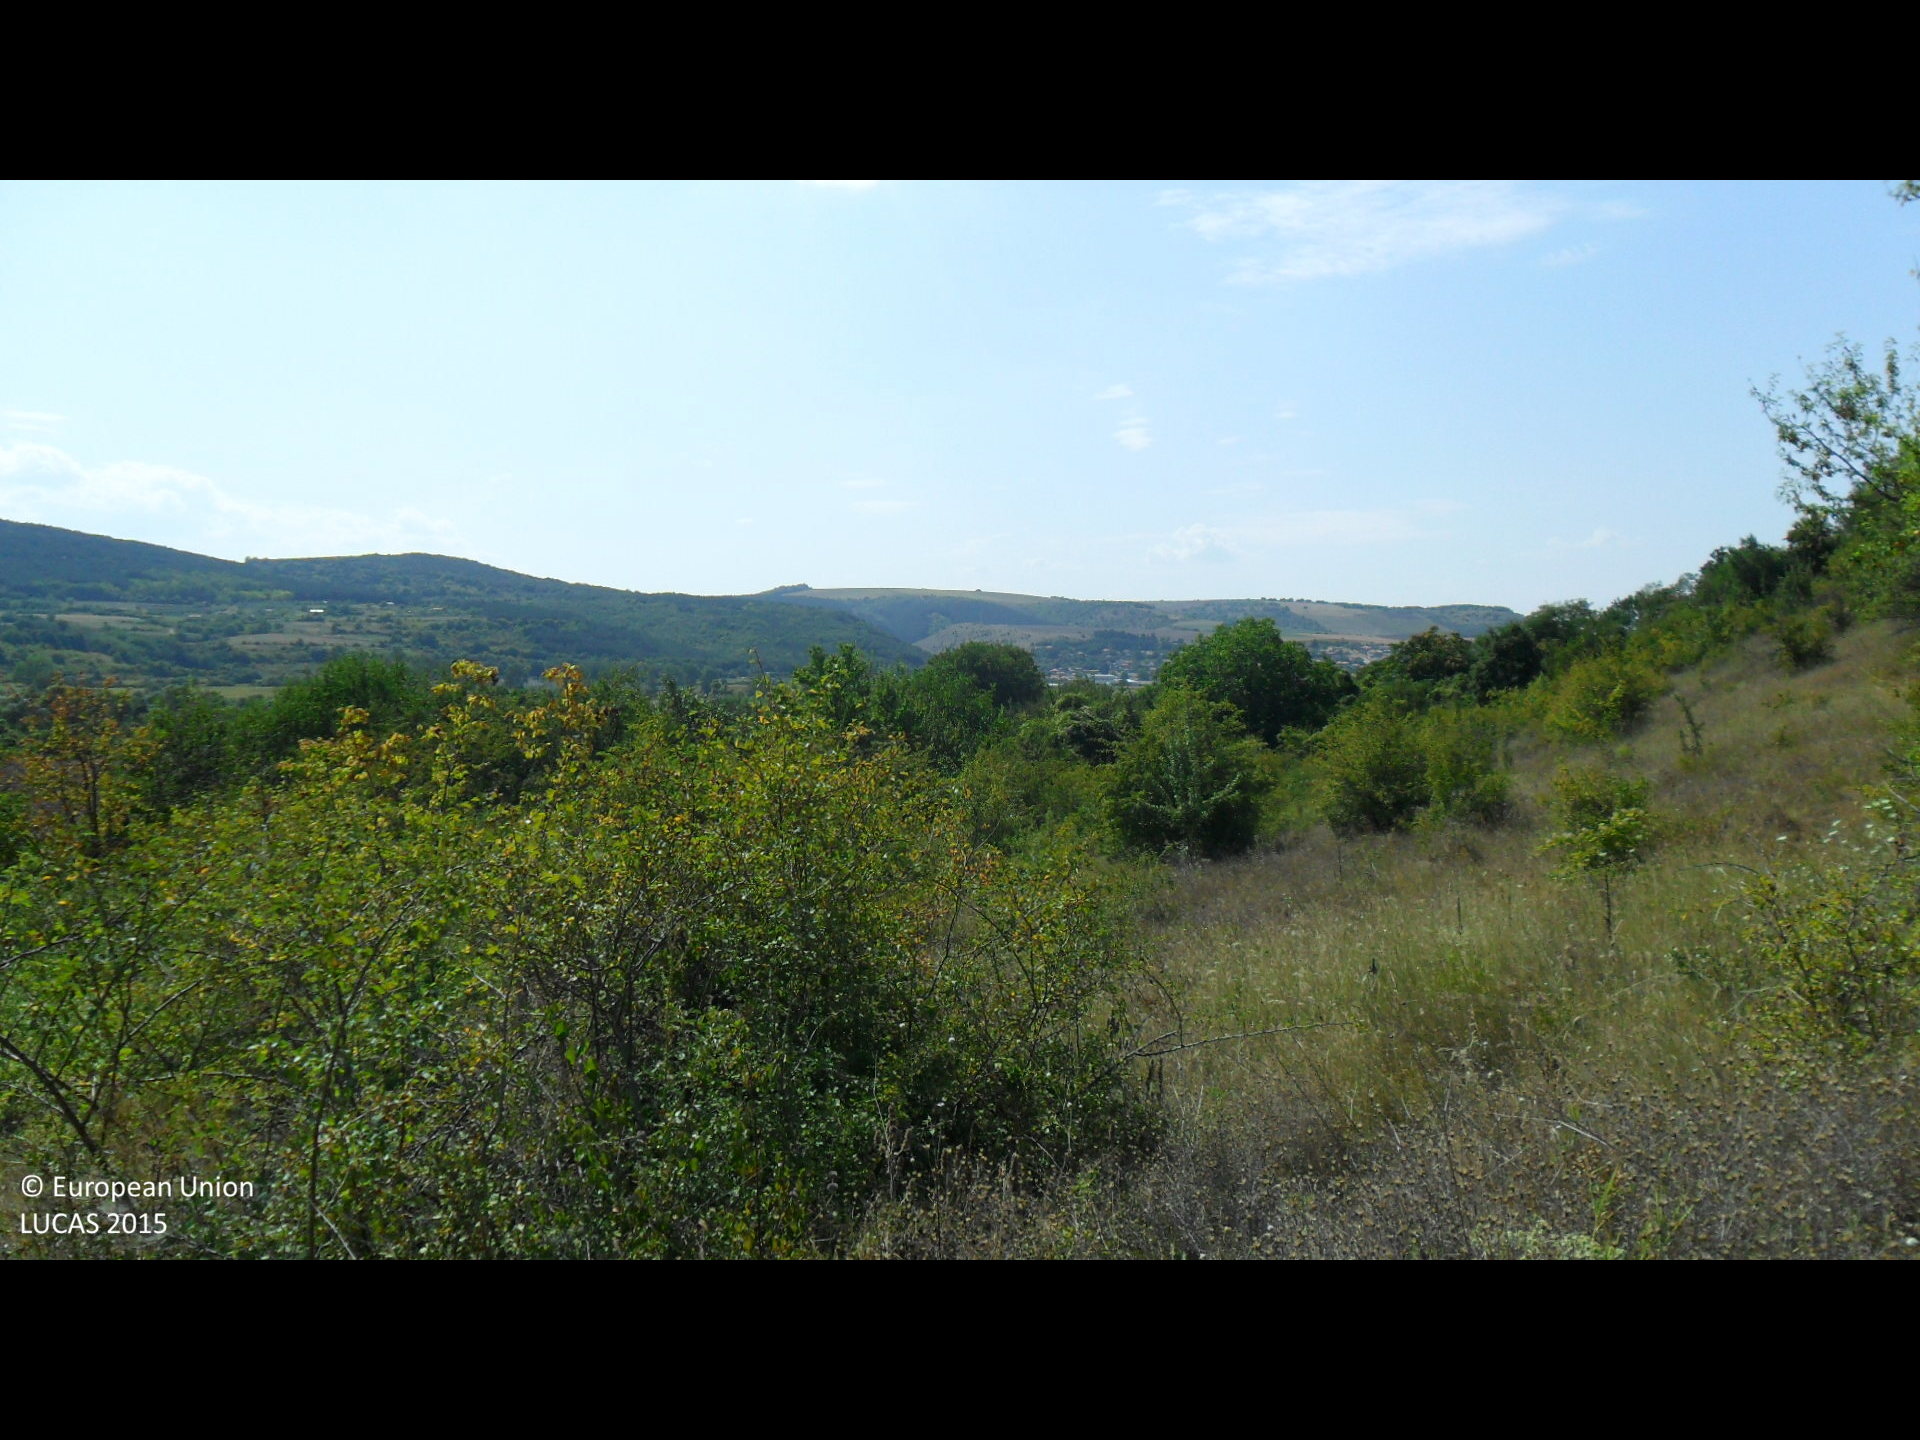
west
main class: Grassland
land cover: Grassland with sparse tree/shrub cover
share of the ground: > 75 %
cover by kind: herbaceous plants 90 %, broadleaved forest trees 5 %, shrubs 5 %
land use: Agriculture (excluding fallow land and kitchen gardens)
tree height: < 5 m
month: August
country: BG
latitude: 43.4785
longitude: 26.1557
